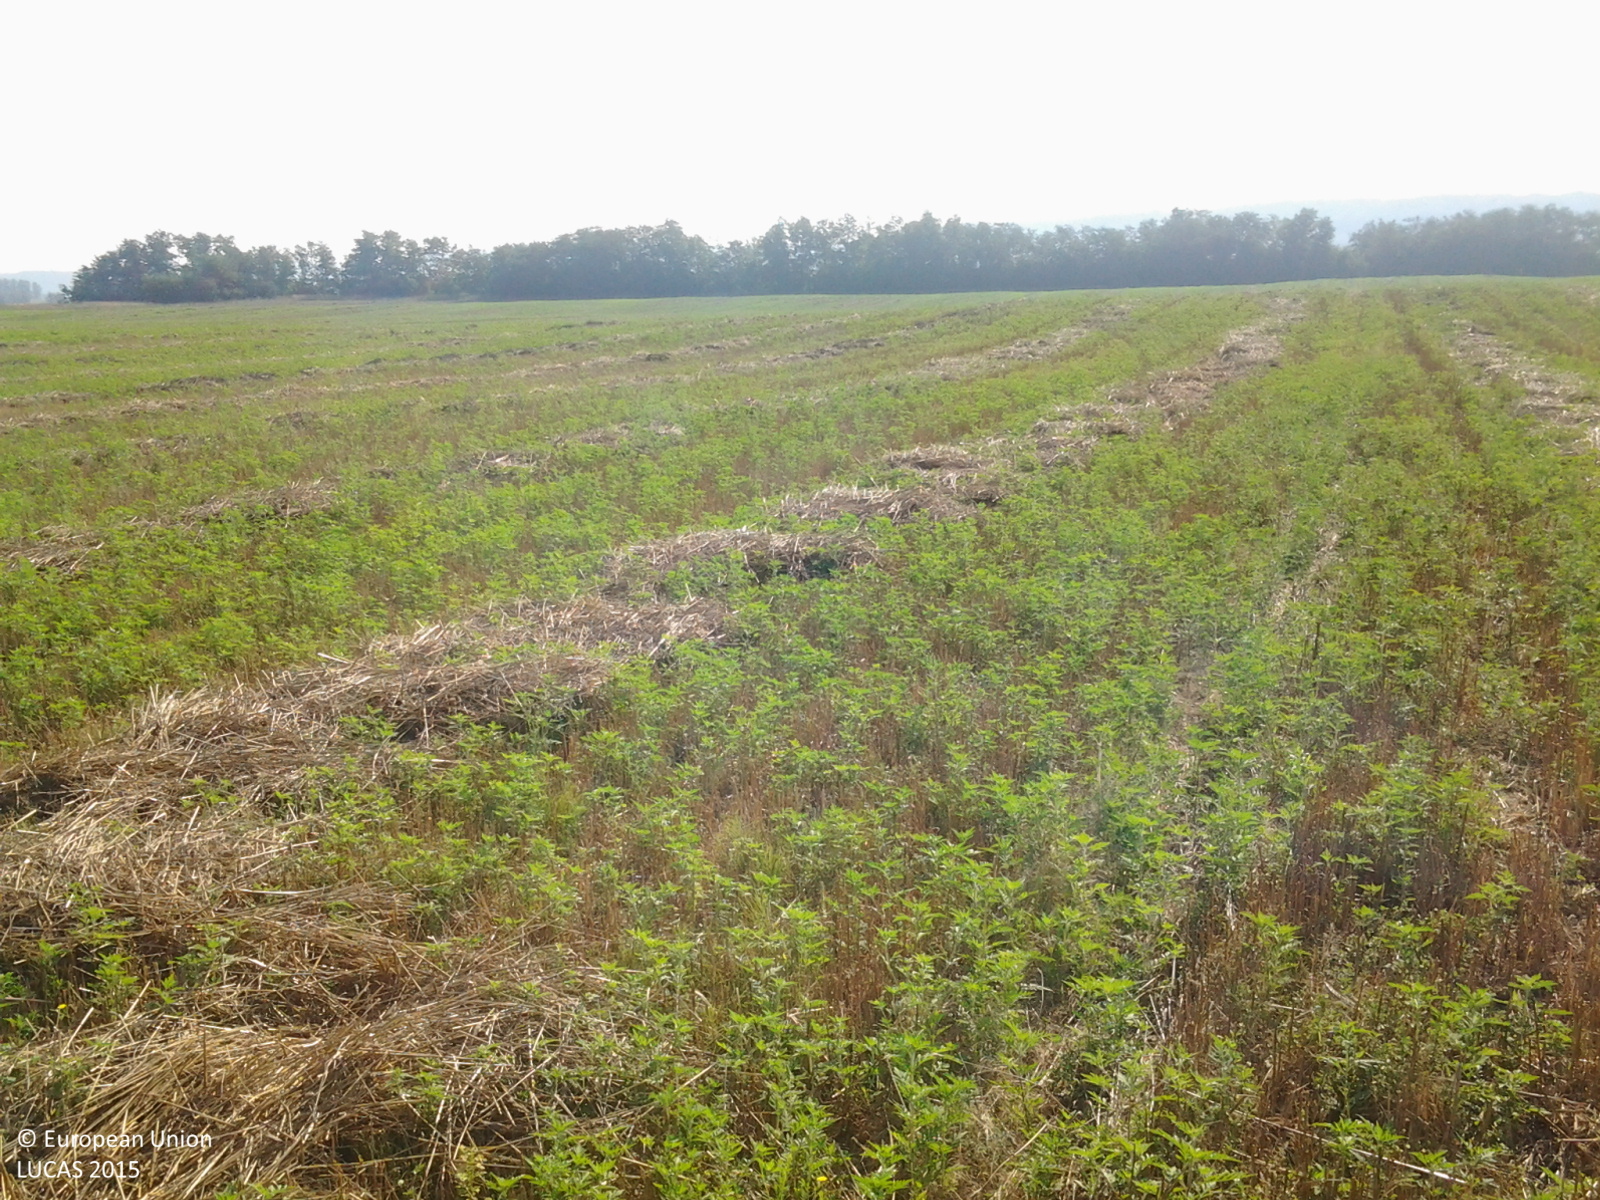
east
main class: Cropland
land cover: Durum wheat
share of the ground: 10 - 25 %
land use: Agriculture (excluding fallow land and kitchen gardens)
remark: Harvested field
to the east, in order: Durum wheat
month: August
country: HU
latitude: 46.3968
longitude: 18.2148
